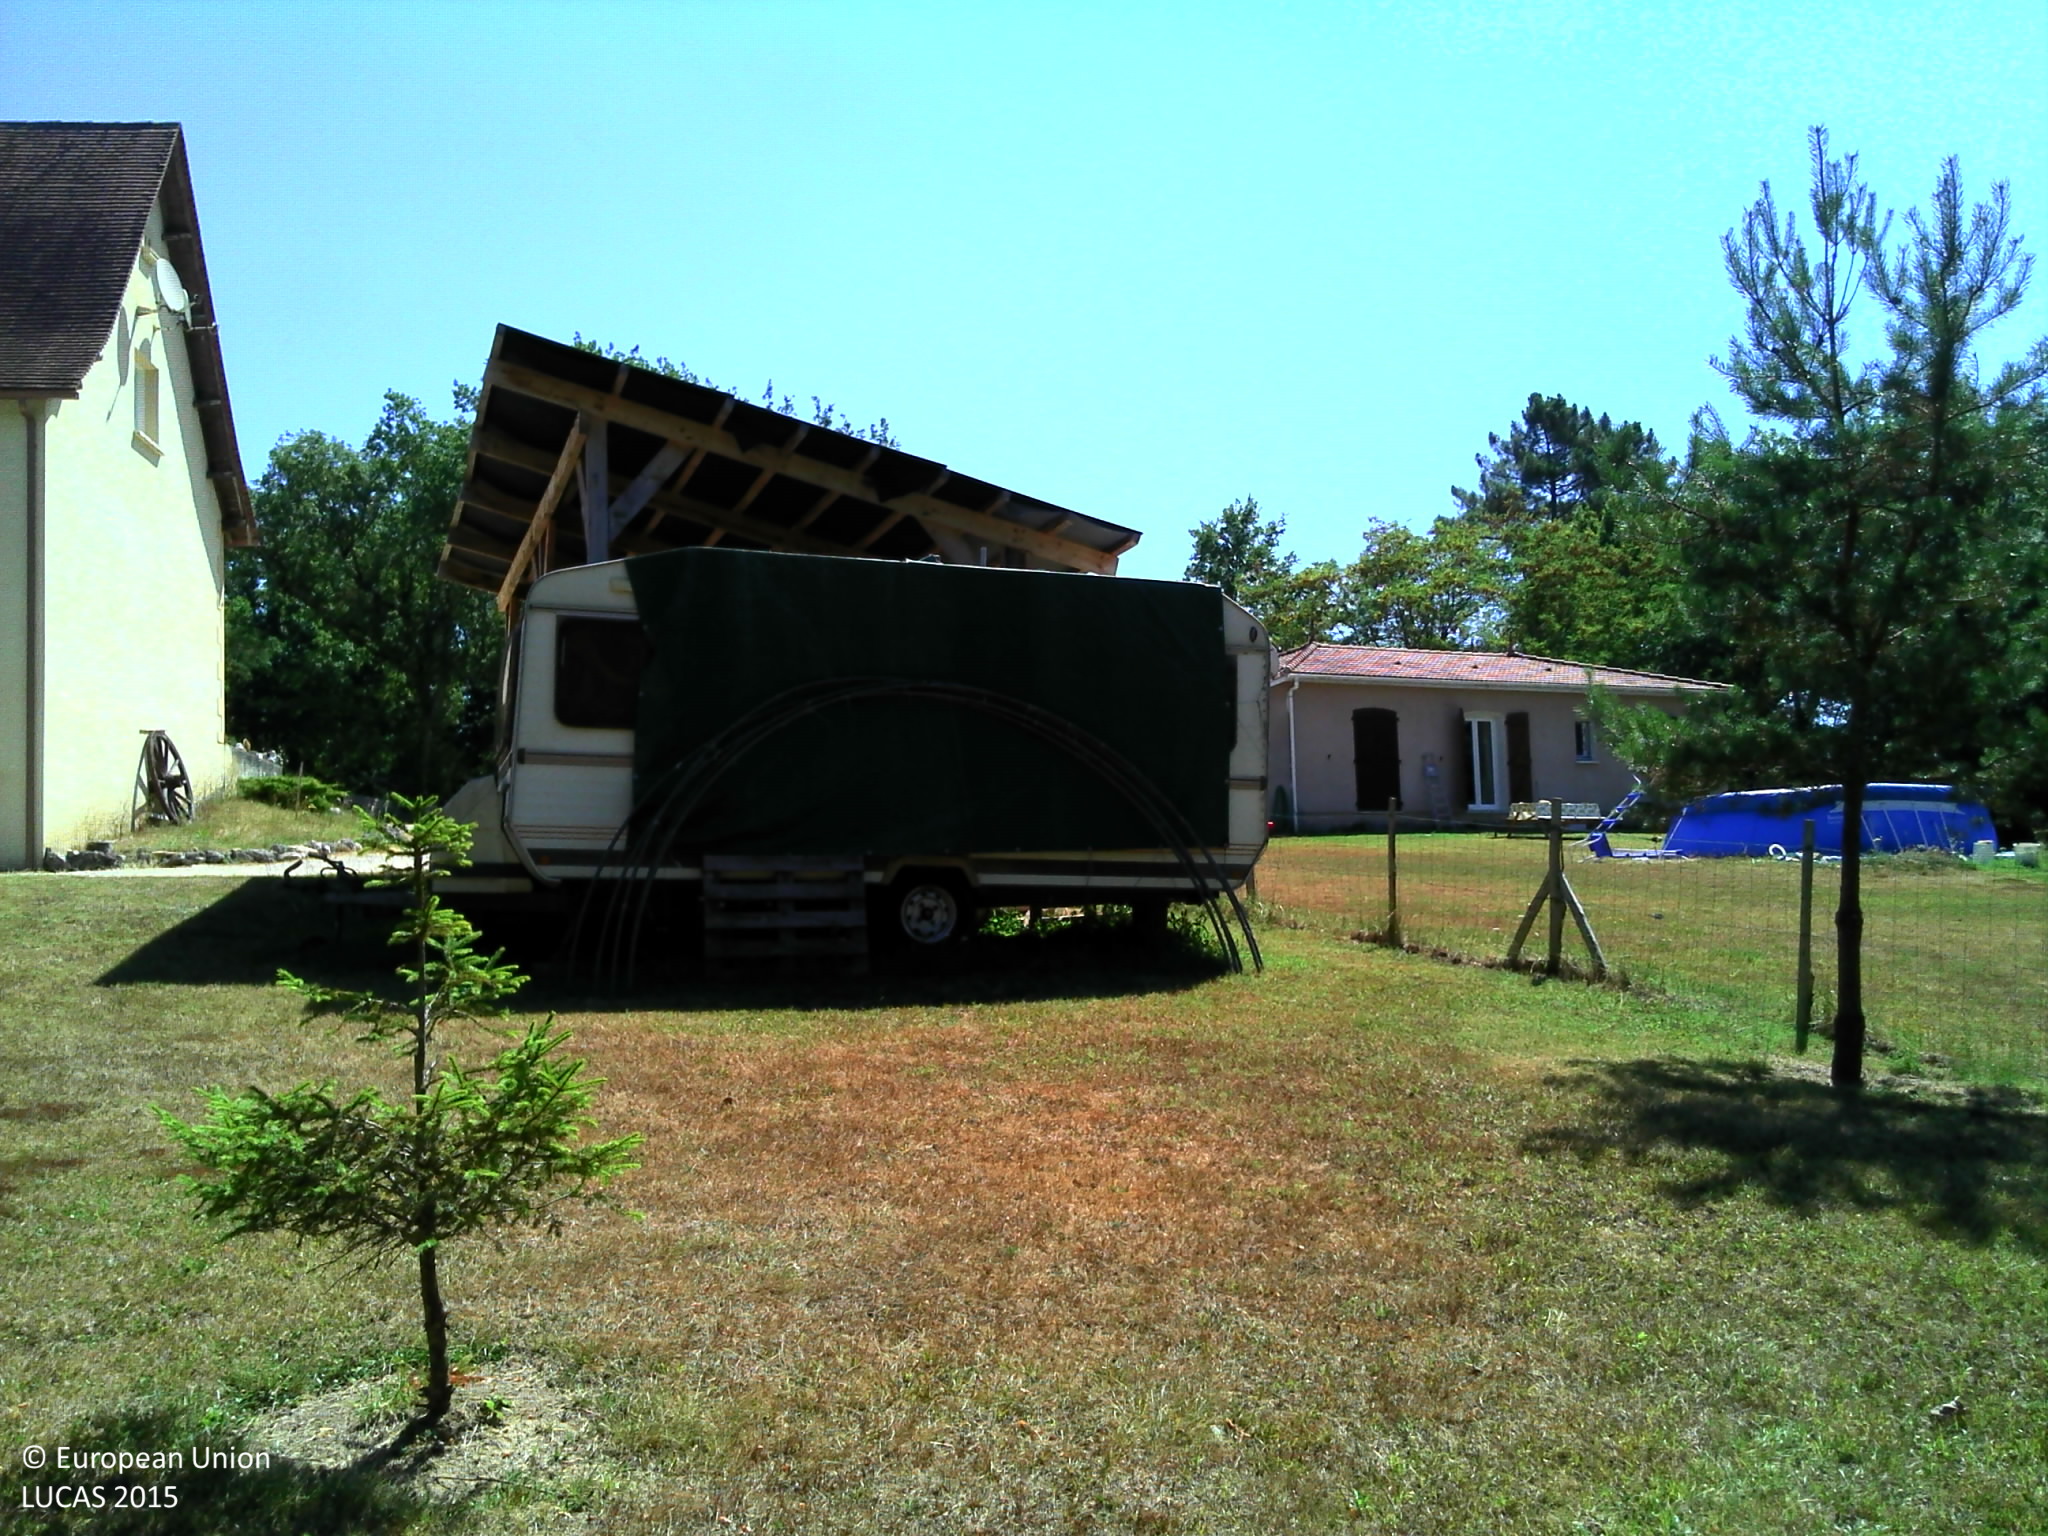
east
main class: Grassland
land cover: Grassland with sparse tree/shrub cover
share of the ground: > 75 %
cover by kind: herbaceous plants 95 %, broadleaved forest trees 5 %
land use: Residential
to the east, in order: Grassland with sparse tree/shrub cover; Artificial constructions in urban areas; Broadleaved woodland
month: July
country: FR
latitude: 44.9011
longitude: 0.5812
